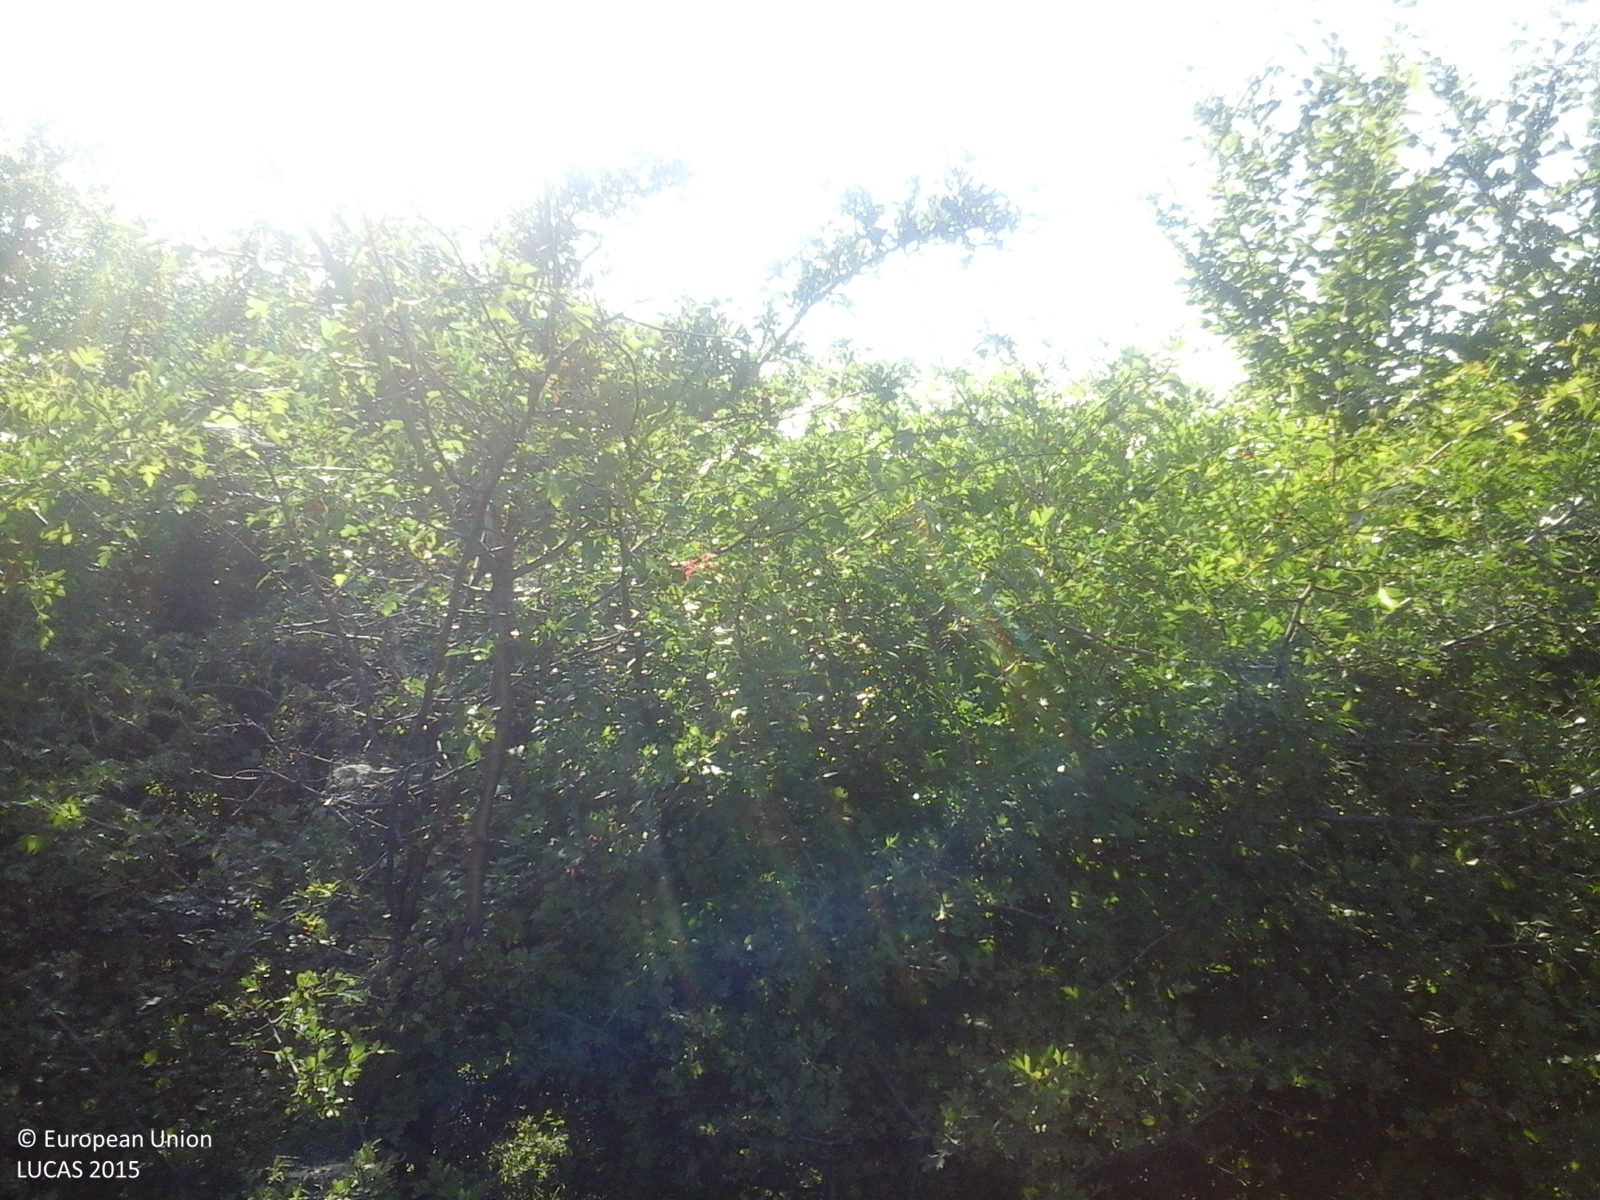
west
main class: Shrubland
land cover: Shrubland with sparse tree cover
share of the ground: > 75 %
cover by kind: herbaceous plants 85 %, shrubs 10 %, broadleaved forest trees 5 %
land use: Agriculture (excluding fallow land and kitchen gardens)
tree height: < 5 m
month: June
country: RO
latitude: 46.9990
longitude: 27.3509
